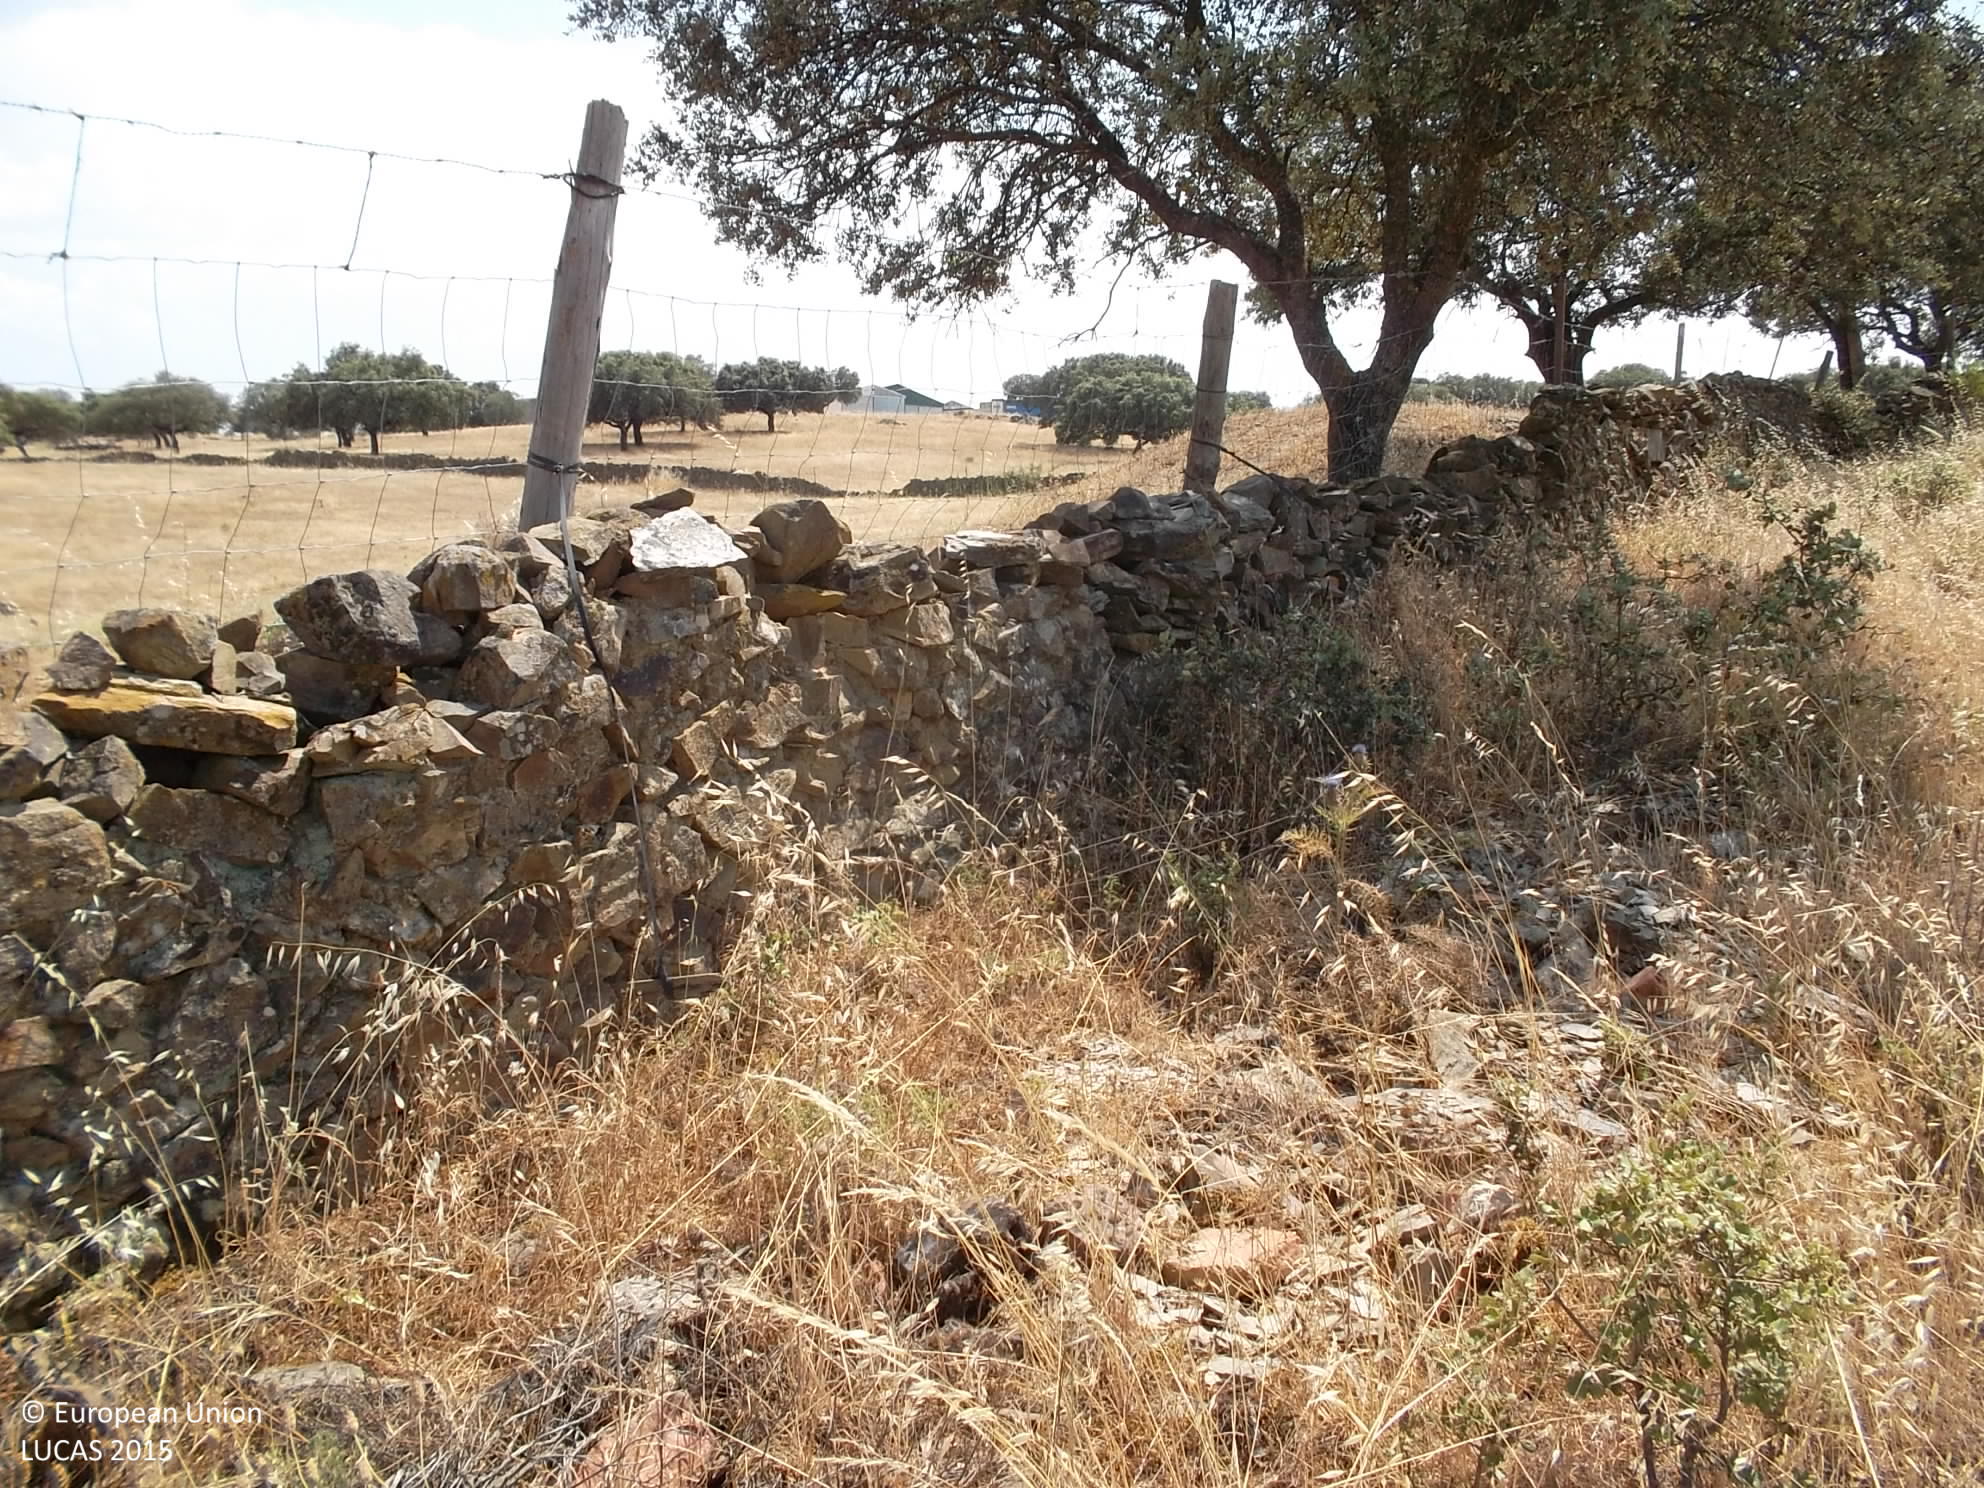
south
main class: Woodland
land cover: Broadleaved woodland
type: broadleaved evergreen forest
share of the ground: 25 - 50 %
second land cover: Spontaneously vegetated surfaces
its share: > 75 %
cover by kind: herbaceous plants 60 %, broadleaved forest trees 30 %, shrubs 10 %
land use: Forestry
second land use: Agriculture (excluding fallow land and kitchen gardens)
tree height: > 5 m
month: June
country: ES
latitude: 39.1332
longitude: -4.9487
